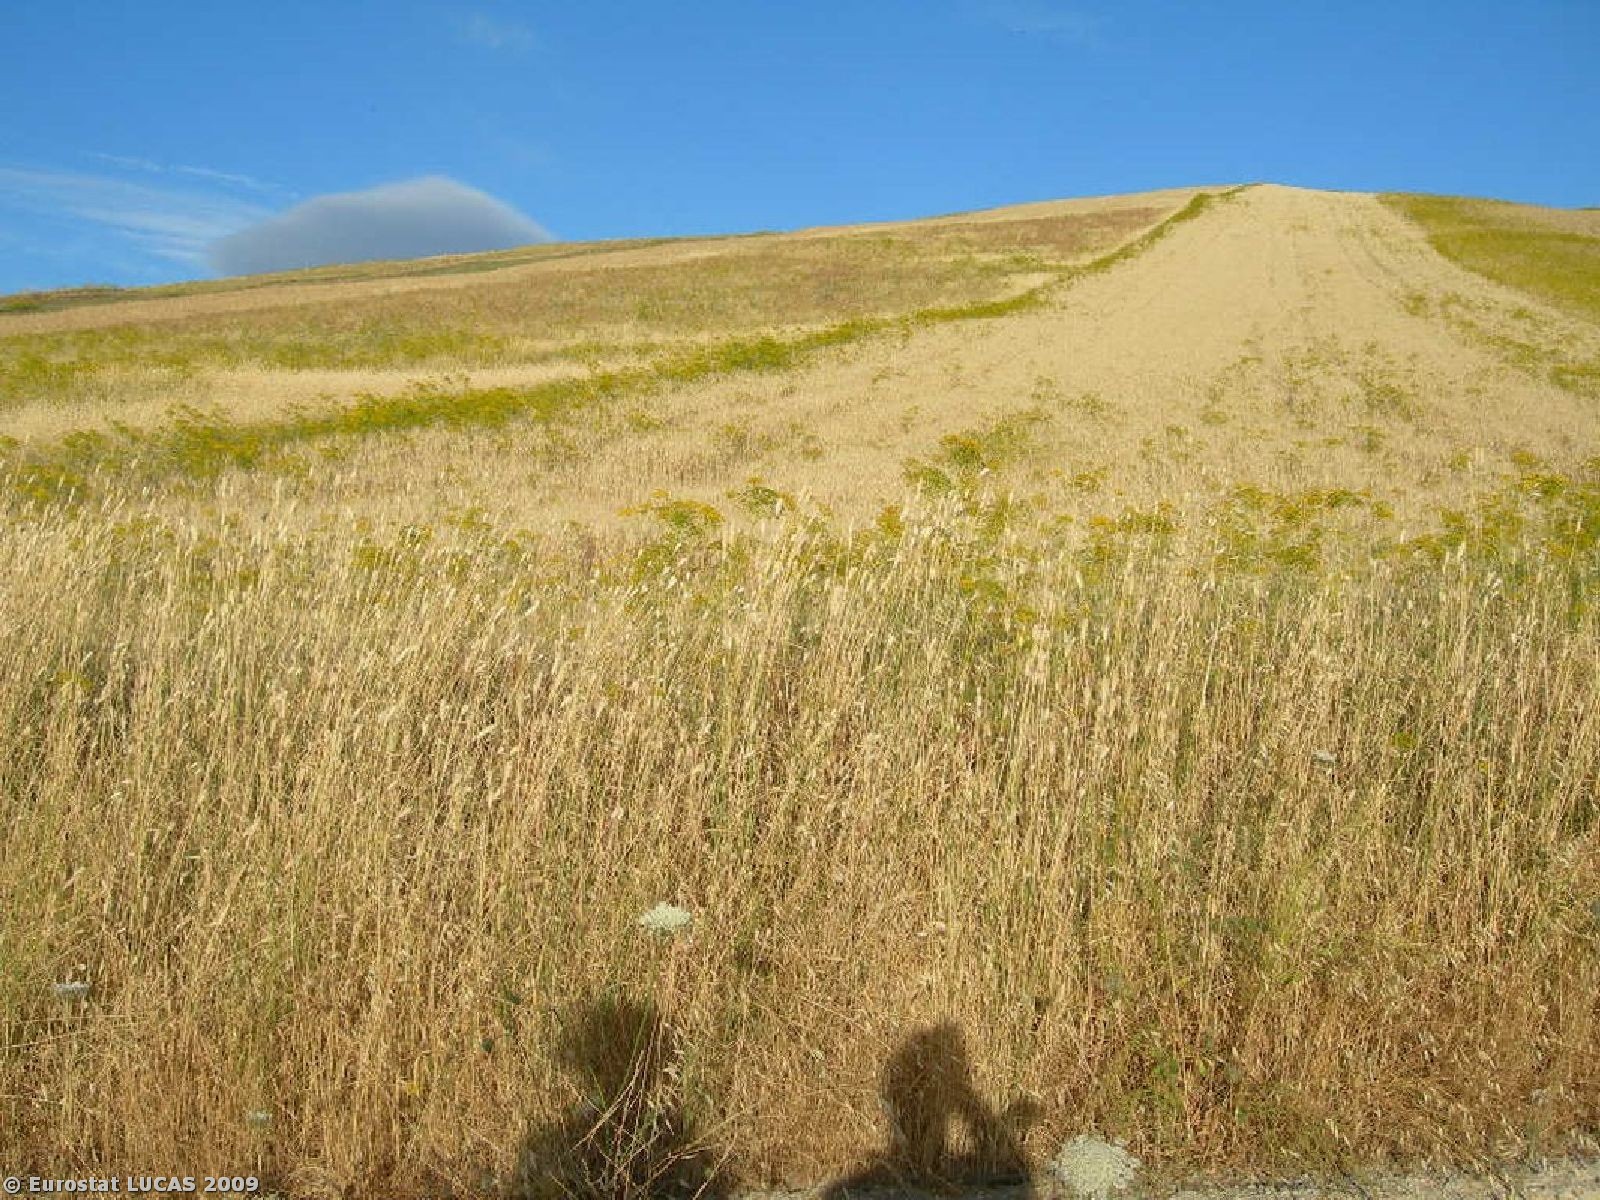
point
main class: Grassland
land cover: Spontaneously vegetated surfaces
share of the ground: > 75 %
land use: Fallow land
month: June
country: IT
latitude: 37.7332
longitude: 14.0669
